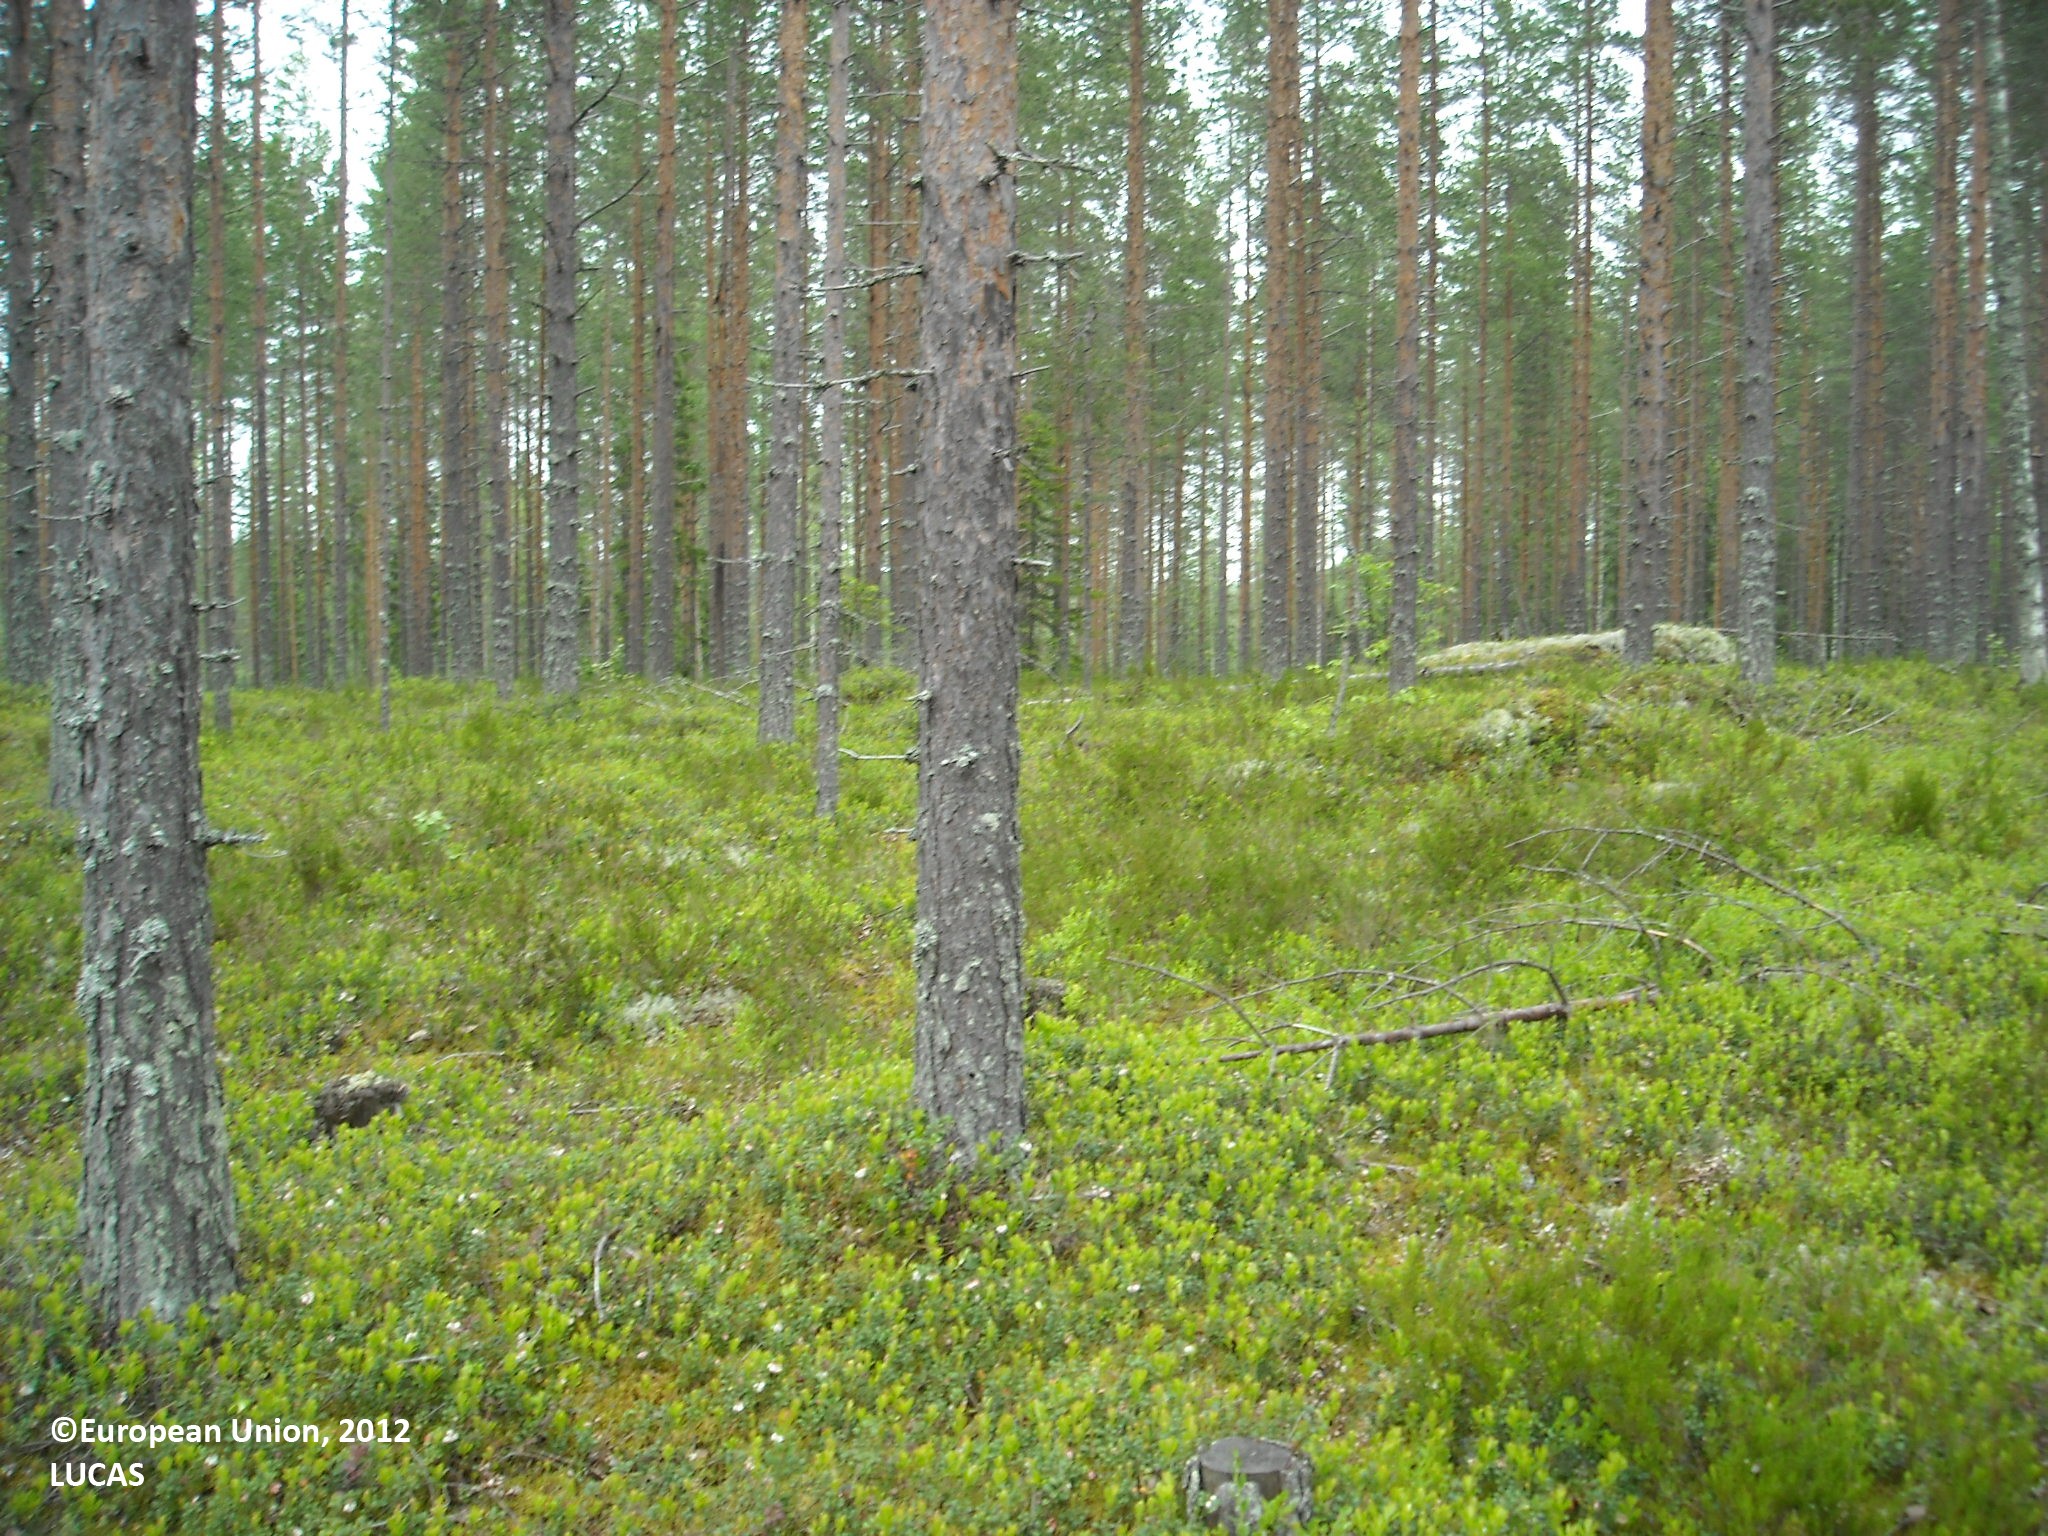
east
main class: Woodland
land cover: Pine dominated coniferous woodland
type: boreal forest
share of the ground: 50 - 75 %
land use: Forestry
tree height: > 5 m
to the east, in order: Pine dominated coniferous woodland; Other mixed woodland; Grass margins; Ditches and canals; Grassland without tree/shrub cover; Paved roads, cycling and walking lanes; Grassland without tree/shrub cover; Ditches and canals; Abandoned hedges; Electric lines; Abandoned hedges; Other mixed woodland; Pine dominated coniferous woodland; Peatbogs; Inland water bodies
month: June
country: FI
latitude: 64.4952
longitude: 27.3097
